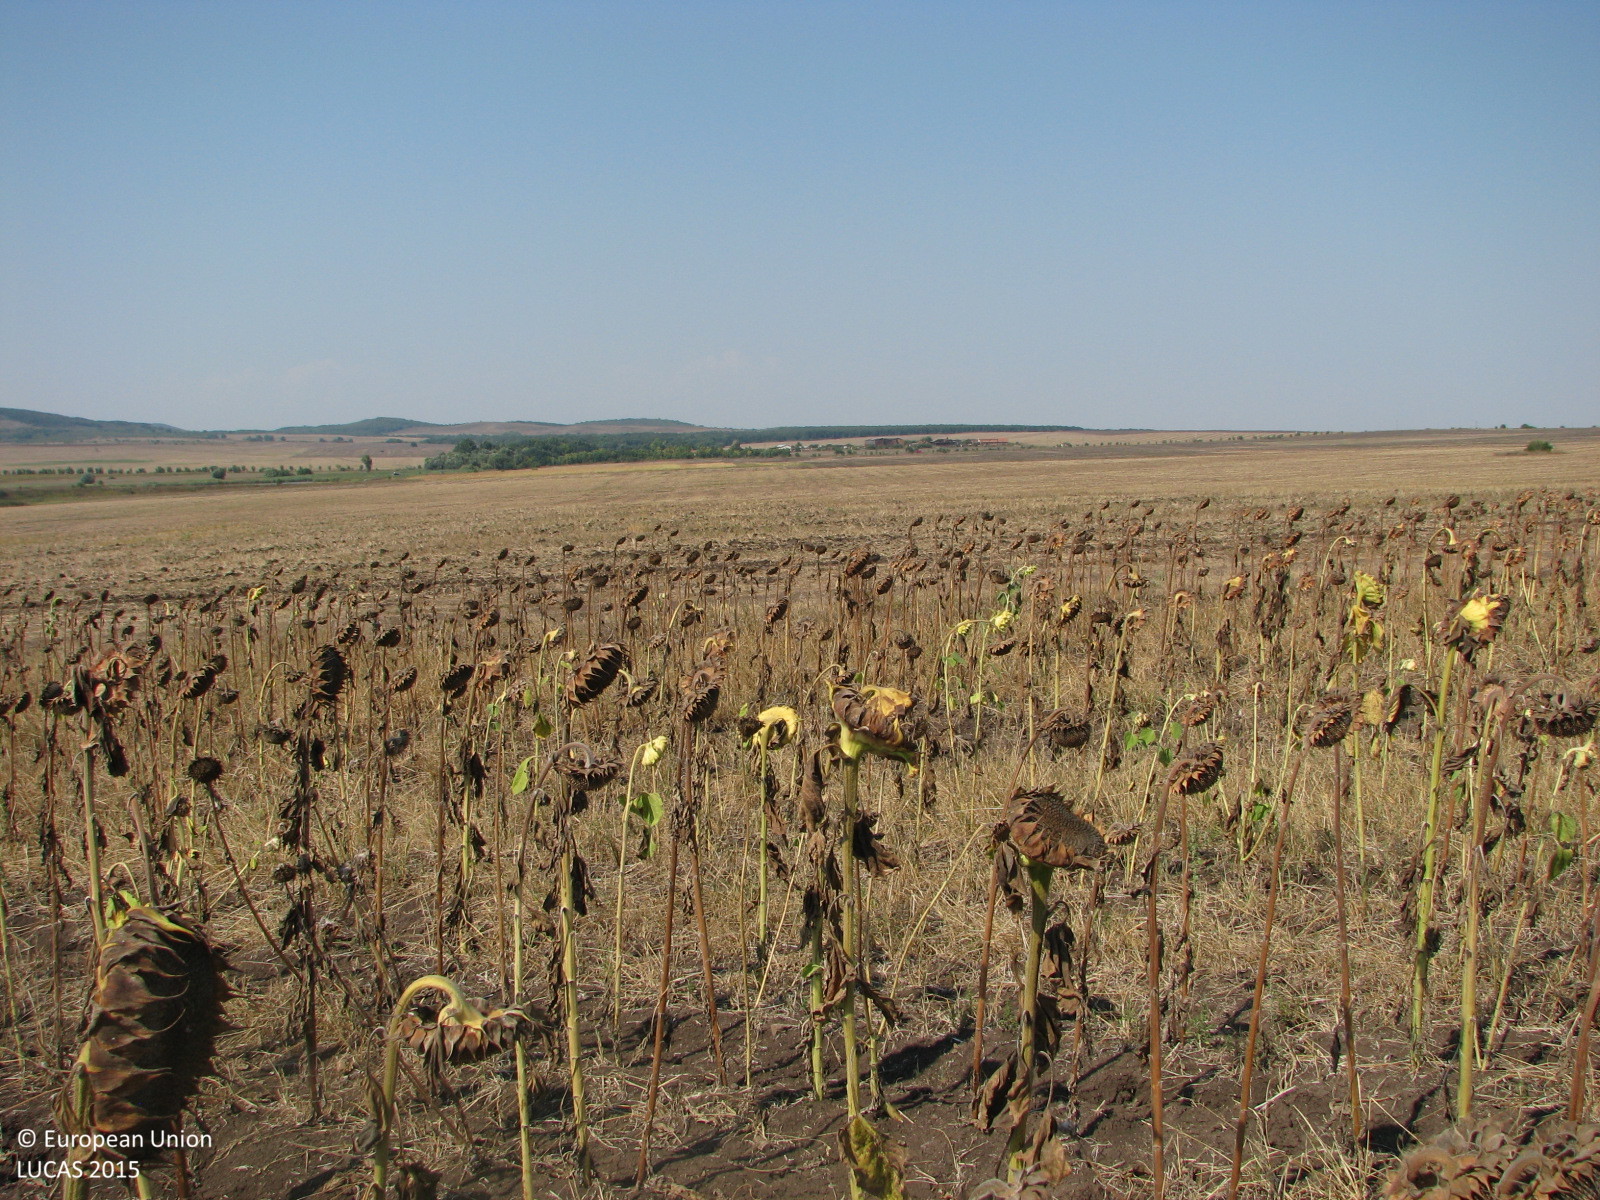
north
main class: Cropland
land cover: Sunflower
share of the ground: 50 - 75 %
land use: Agriculture (excluding fallow land and kitchen gardens)
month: September
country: BG
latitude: 42.3669
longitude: 26.7691
